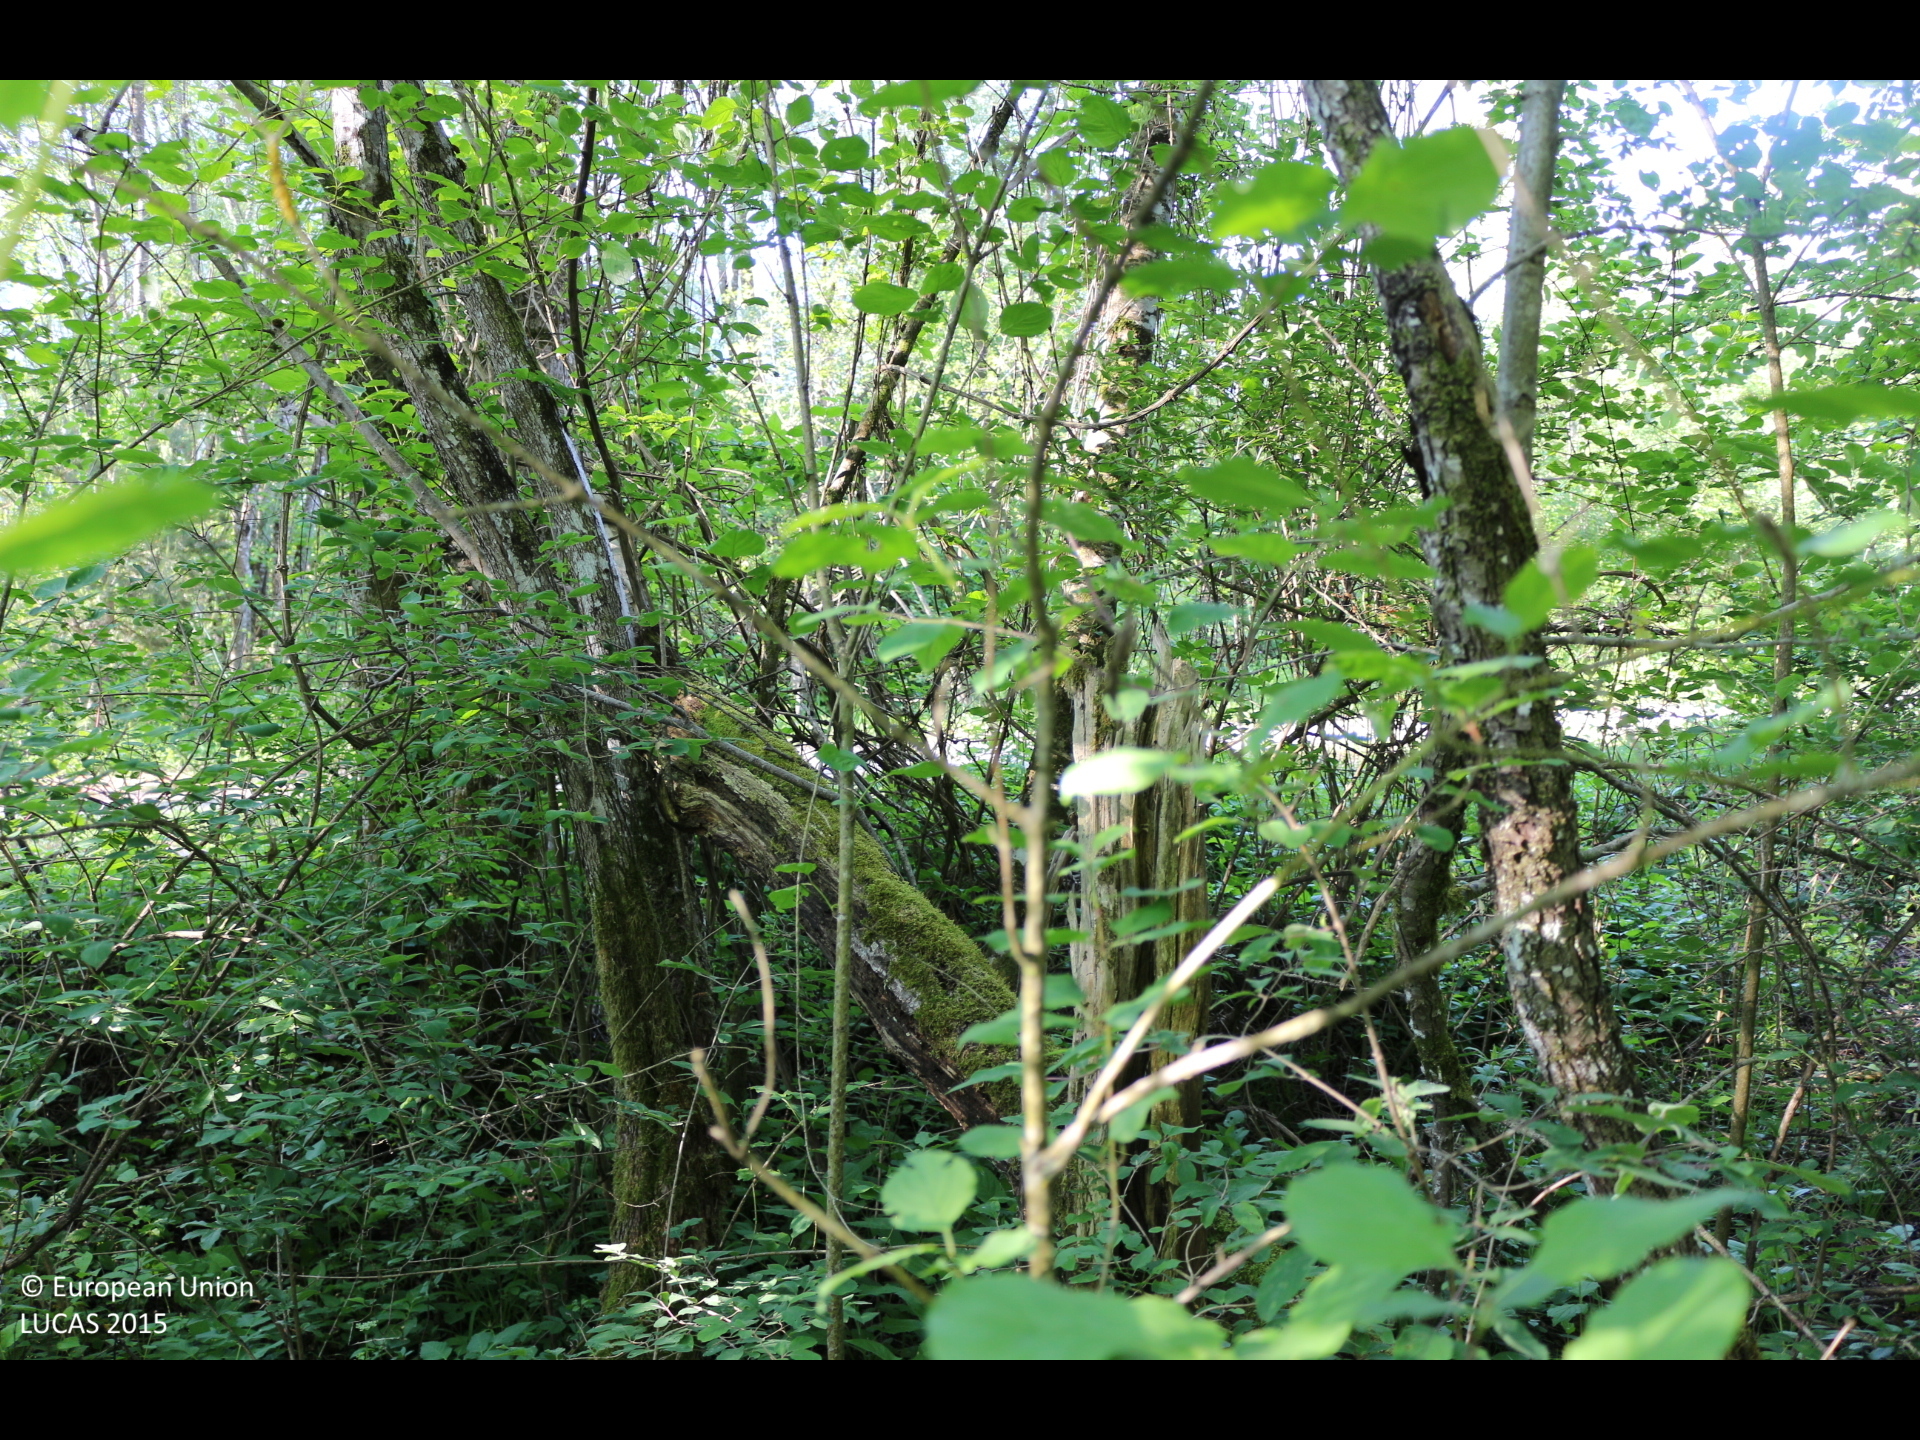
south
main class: Woodland
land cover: Broadleaved woodland
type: floodplain forest
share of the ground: > 75 %
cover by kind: broadleaved forest trees 50 %, shrubs 50 %
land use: Forestry
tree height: > 5 m
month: May
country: AT
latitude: 46.5389
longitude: 14.2090
